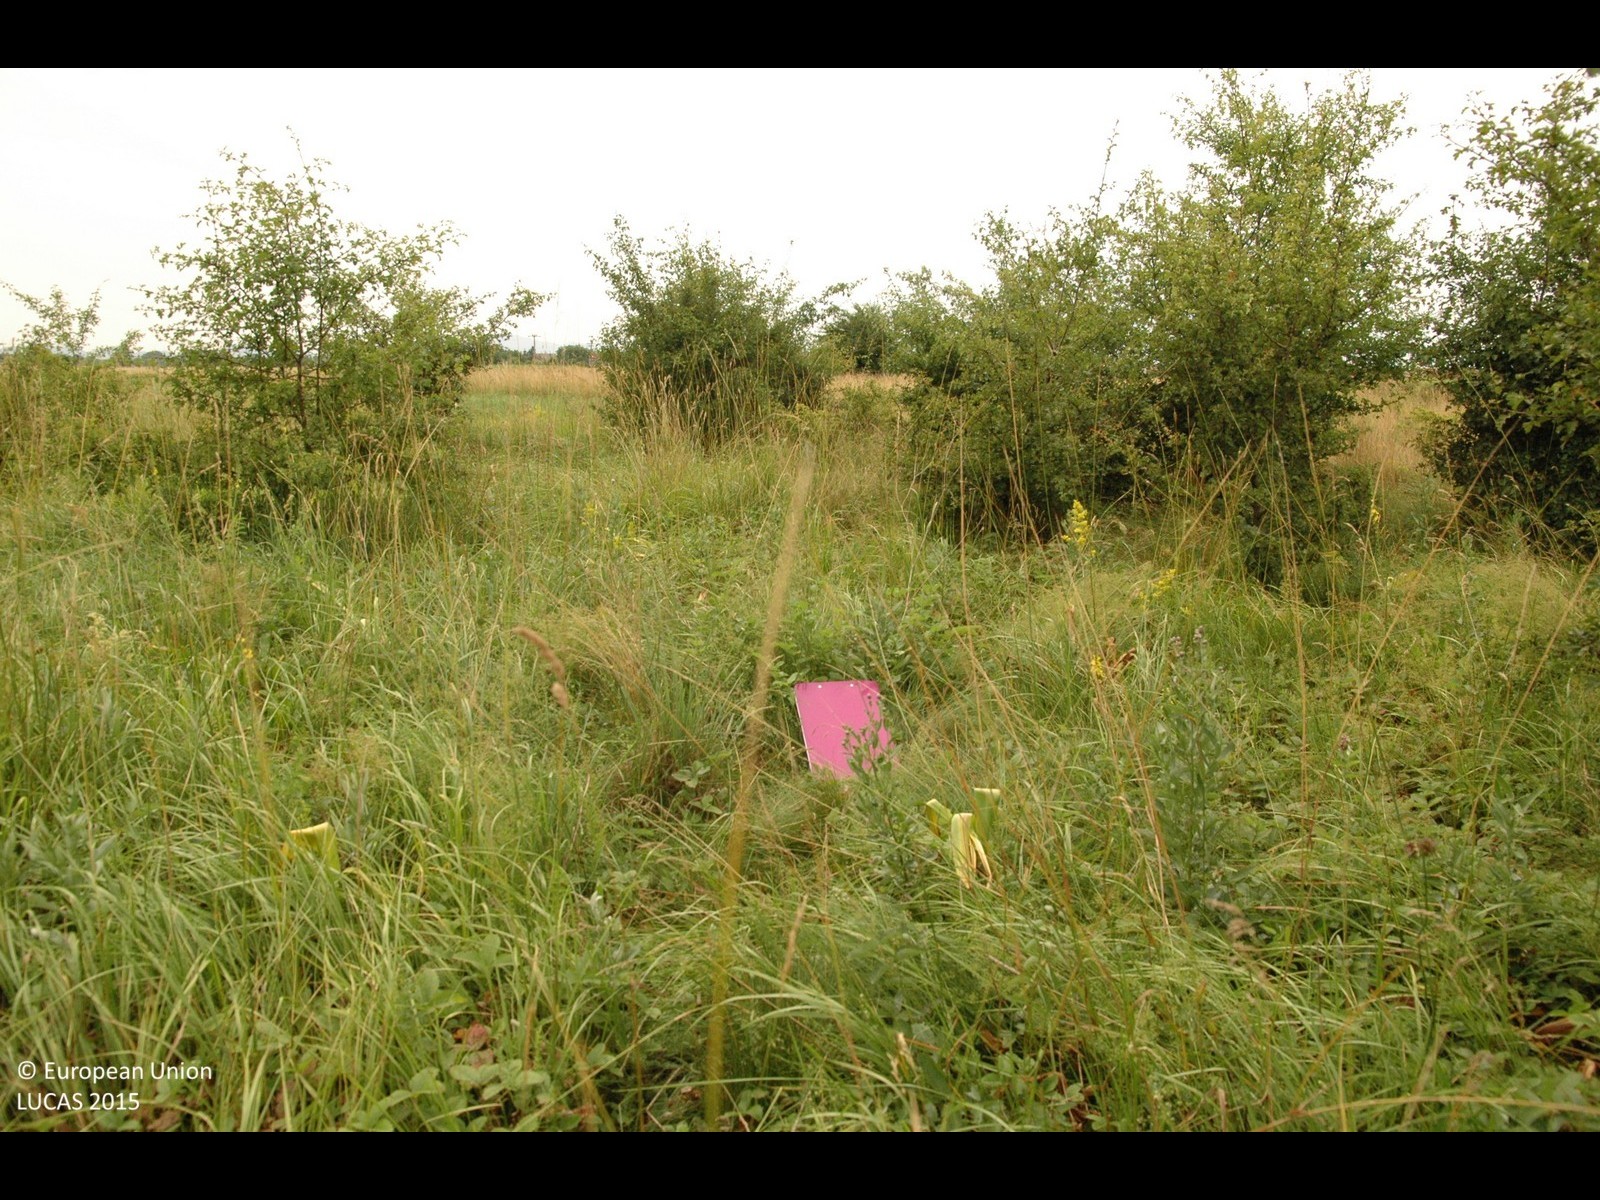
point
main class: Grassland
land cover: Grassland with sparse tree/shrub cover
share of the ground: > 75 %
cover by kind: herbaceous plants 85 %, shrubs 10 %, broadleaved forest trees 5 %
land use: Abandoned areas
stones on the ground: < 10 %
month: June
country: HR
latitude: 46.3788
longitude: 16.3581
